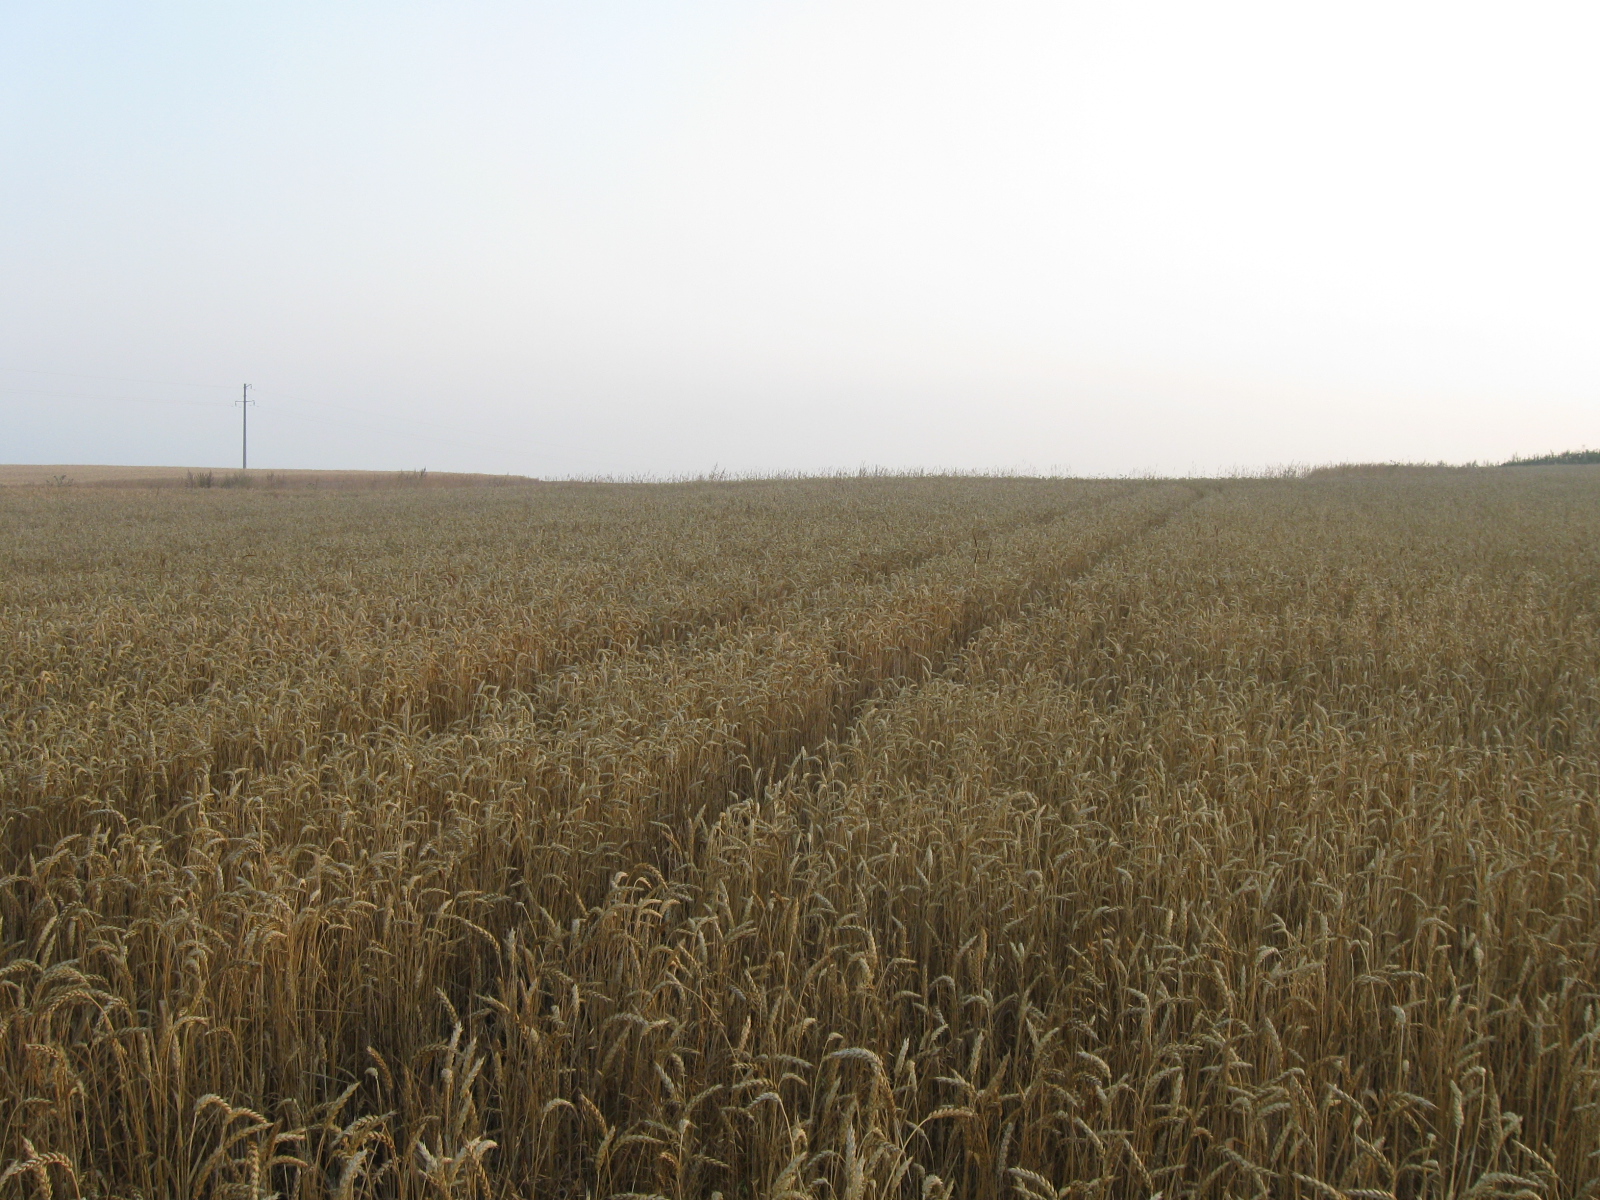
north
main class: Cropland
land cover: Common wheat
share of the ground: > 75 %
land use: Agriculture (excluding fallow land and kitchen gardens)
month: August
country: LT
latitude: 54.5966
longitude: 22.9647
